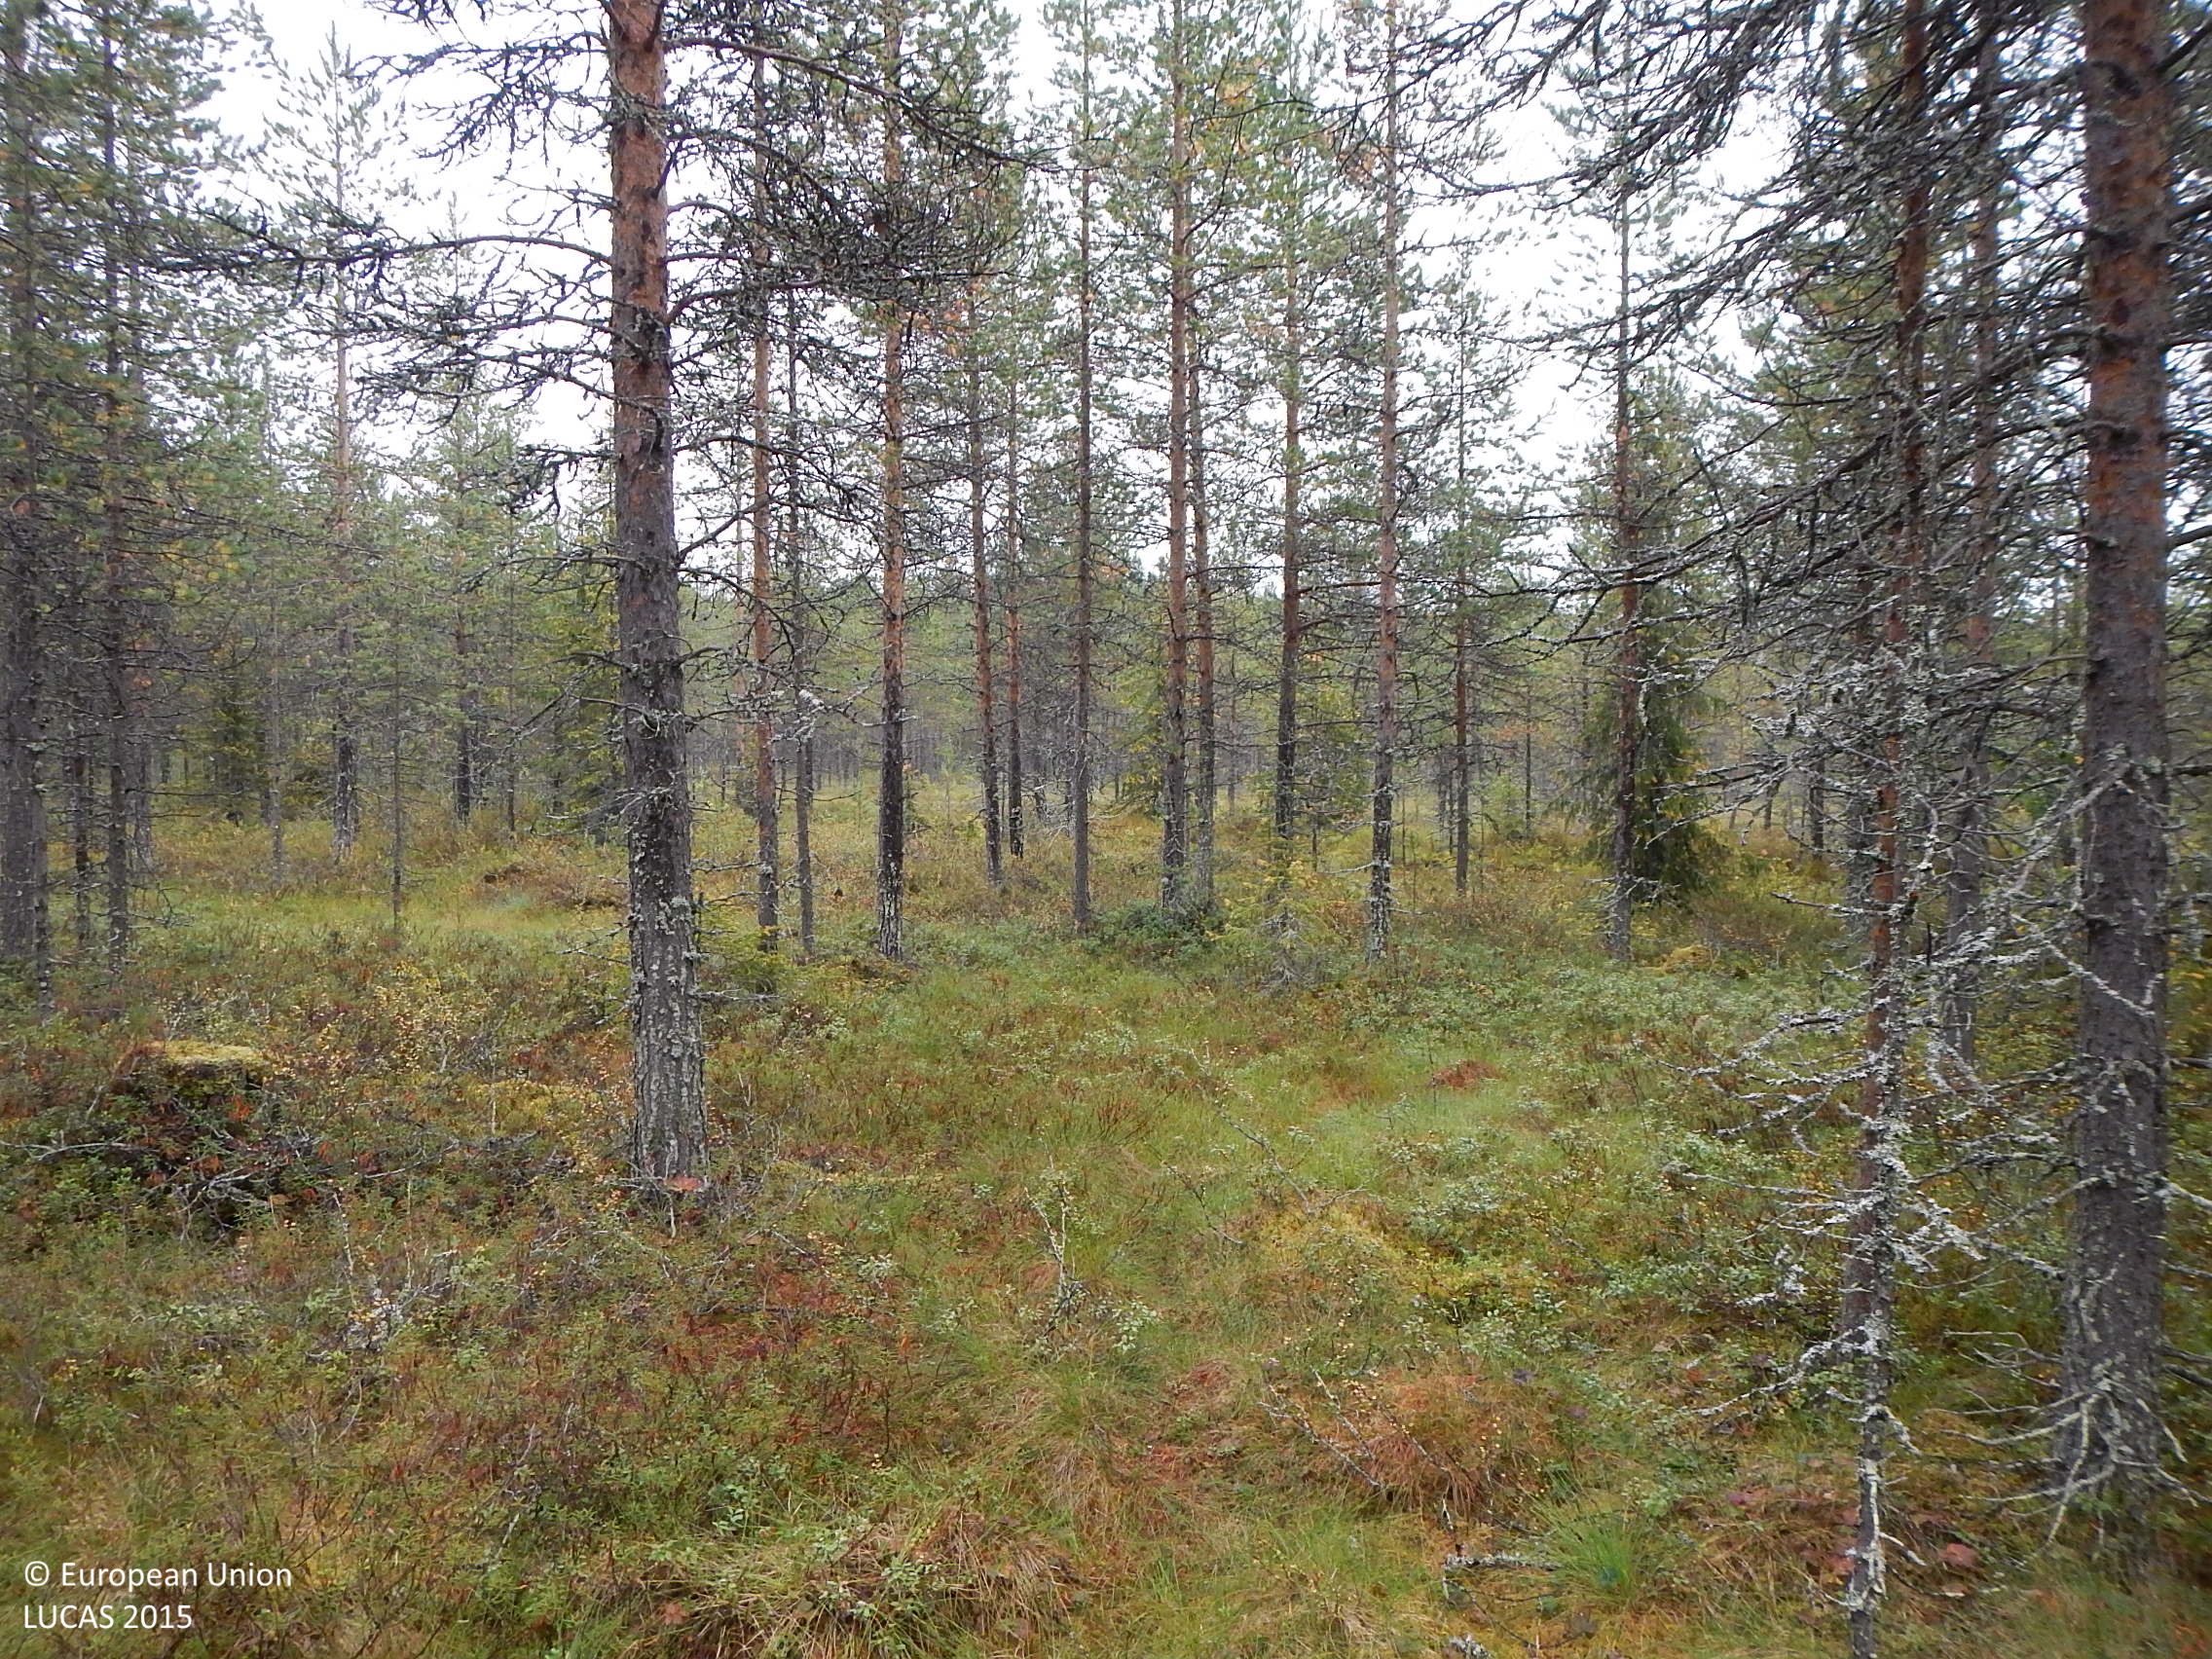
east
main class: Woodland
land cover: Pine dominated coniferous woodland
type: mire and swamp forests
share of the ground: > 75 %
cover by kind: coniferous forest trees 70 %, shrubs 15 %, broadleaved forest trees 10 %, lichens and mosses 5 %
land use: Forestry
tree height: > 5 m
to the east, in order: Pine dominated coniferous woodland; Ditches and canals; Pine dominated coniferous woodland; Ditches and canals; Pine dominated coniferous woodland; Shrubland with sparse tree cover
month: August
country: FI
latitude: 65.8414
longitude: 27.2631
